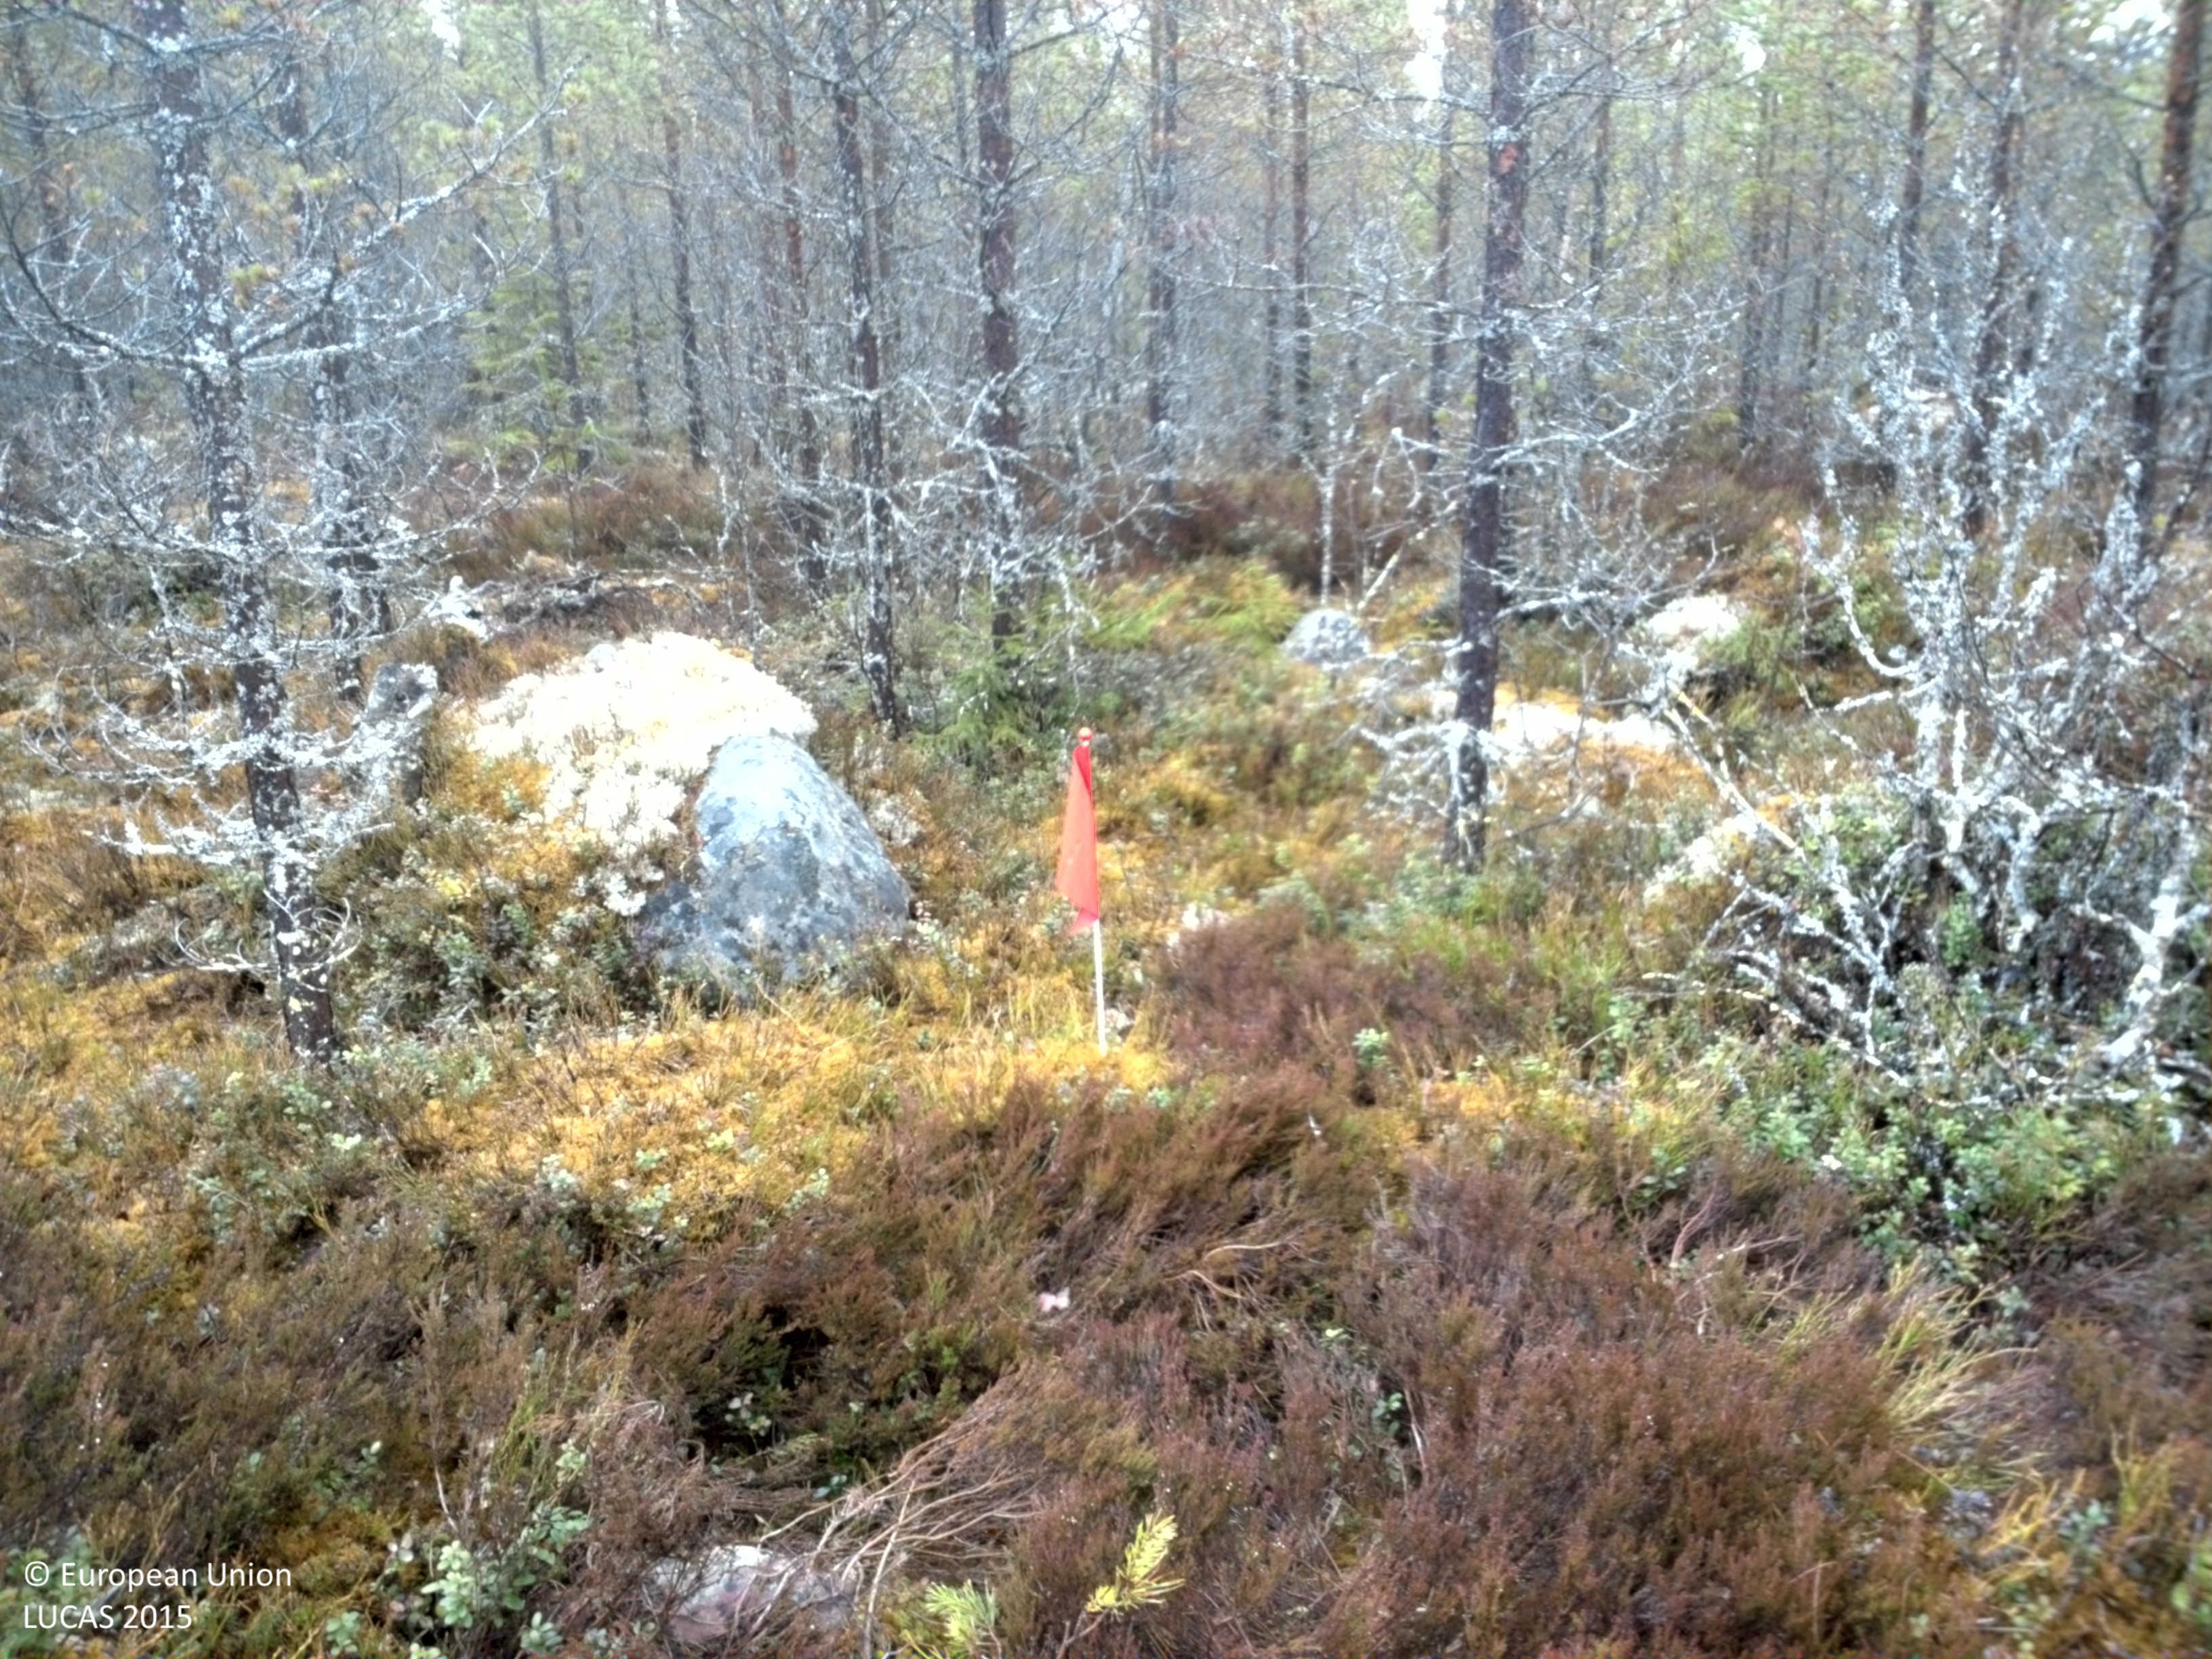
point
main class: Woodland
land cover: Pine dominated coniferous woodland
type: boreal forest
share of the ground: 50 - 75 %
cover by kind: coniferous forest trees 75 %, shrubs 25 %
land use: Forestry
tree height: < 5 m
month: May
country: SE
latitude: 60.9659
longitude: 13.5166
